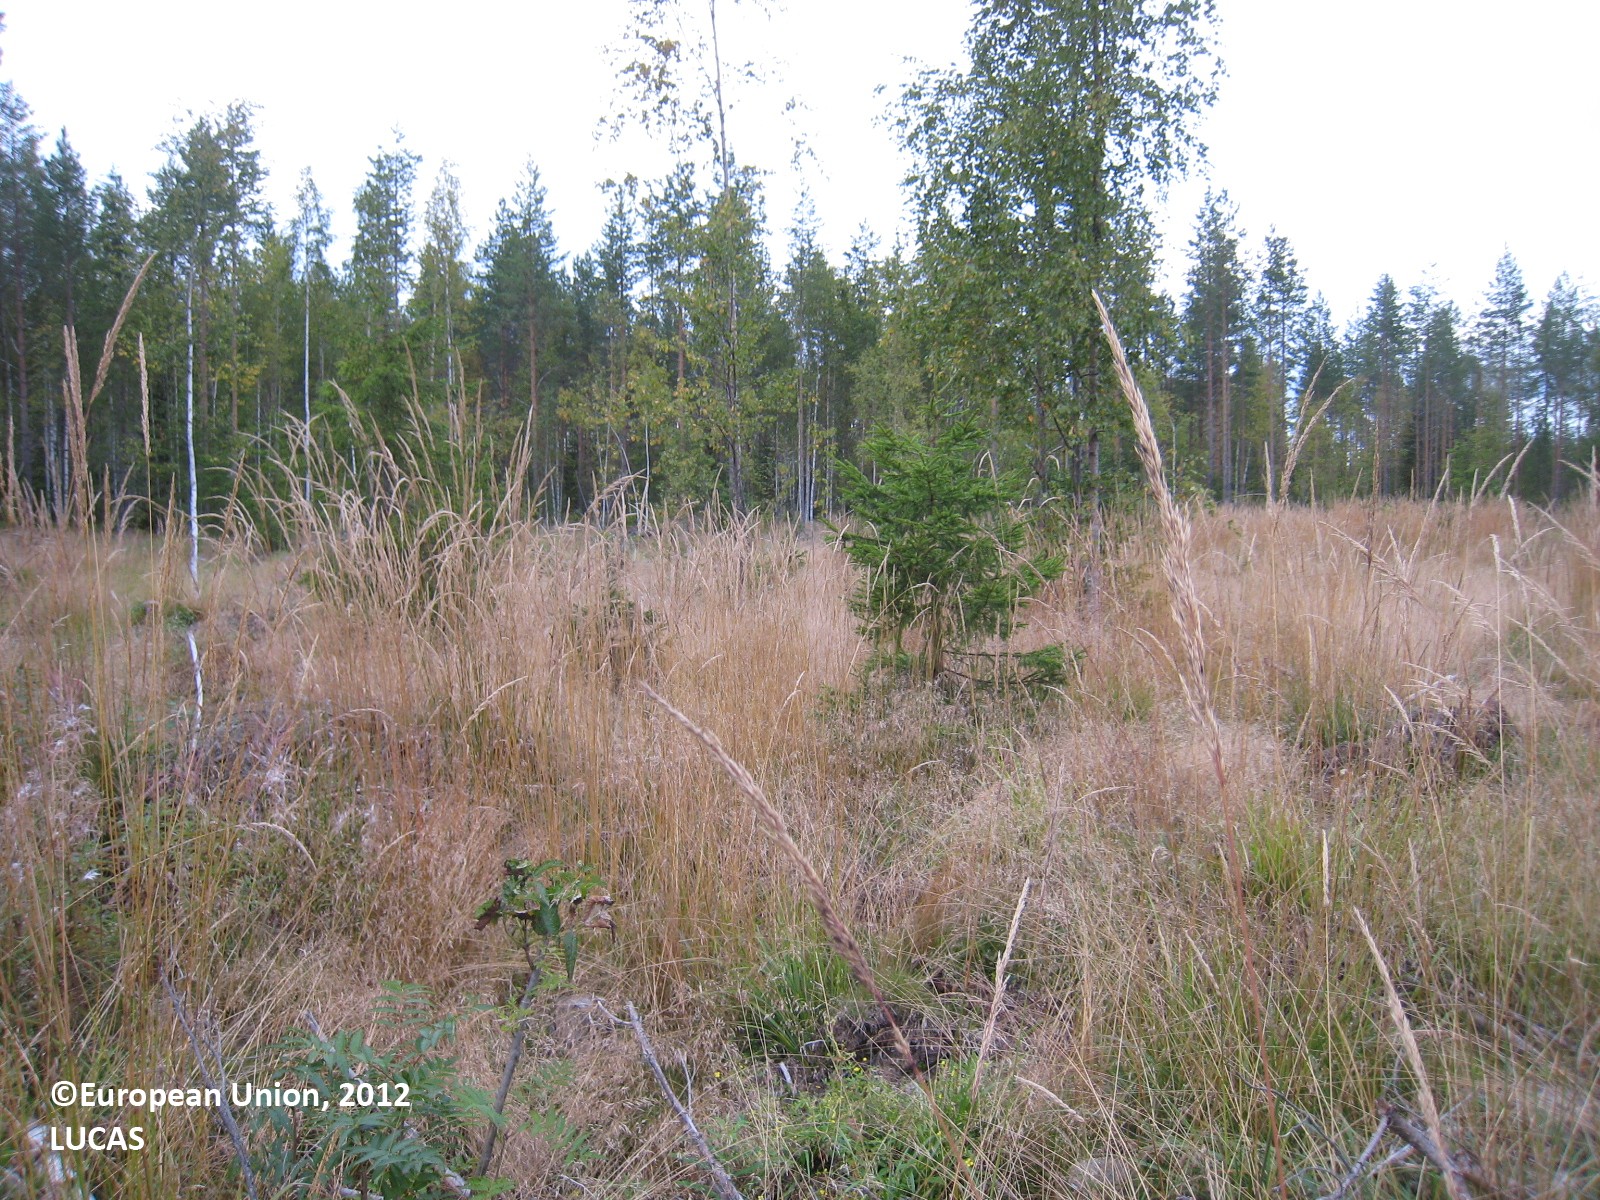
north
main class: Grassland
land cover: Grassland with sparse tree/shrub cover
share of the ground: > 75 %
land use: Forestry
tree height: < 5 m
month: August
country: FI
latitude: 62.3371
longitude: 27.3279
